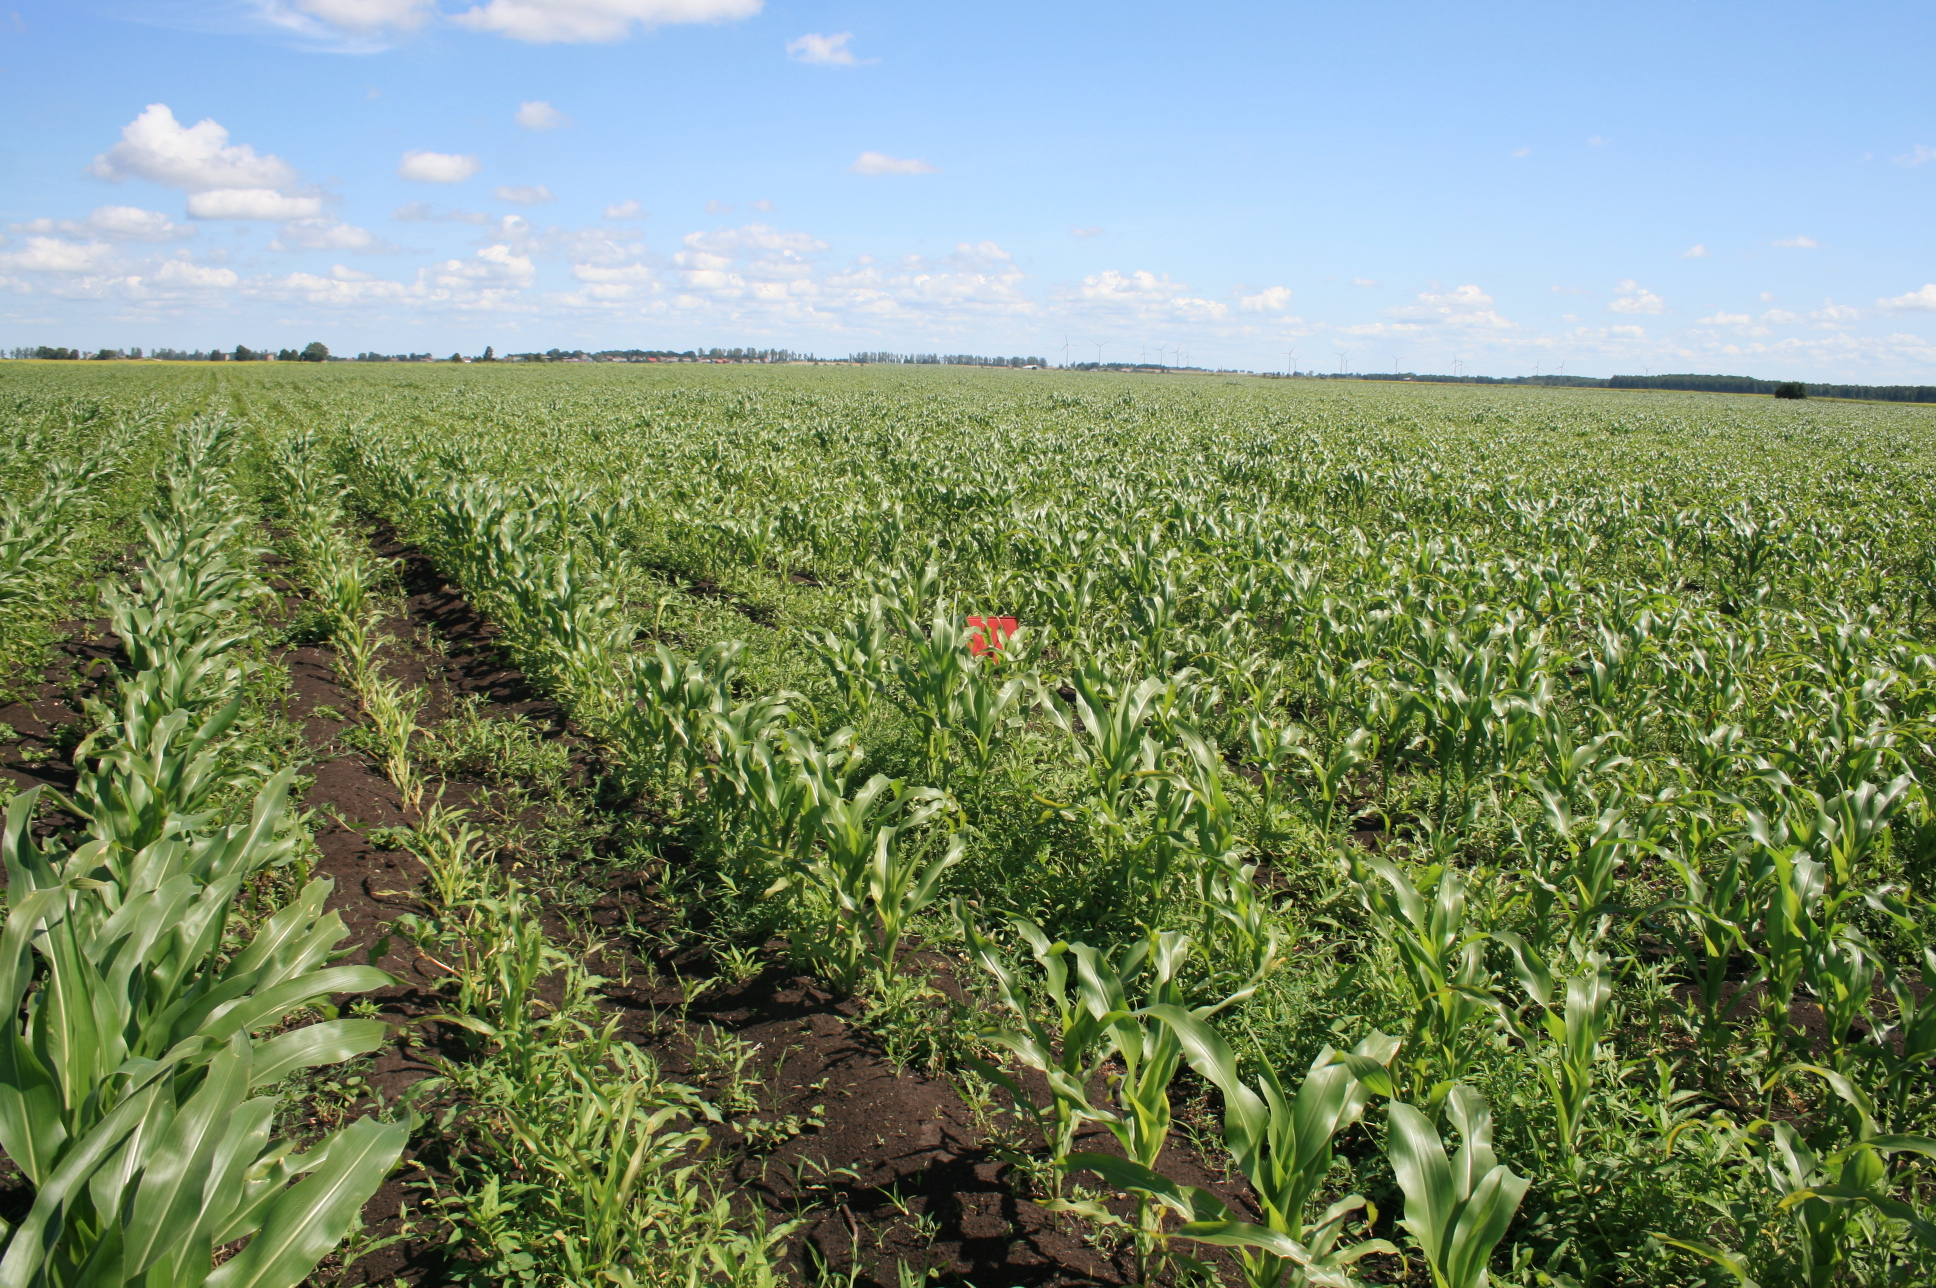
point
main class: Cropland
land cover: Maize
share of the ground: > 75 %
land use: Agriculture (excluding fallow land and kitchen gardens)
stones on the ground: < 10 %
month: July
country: LT
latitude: 55.5079
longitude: 21.2689
